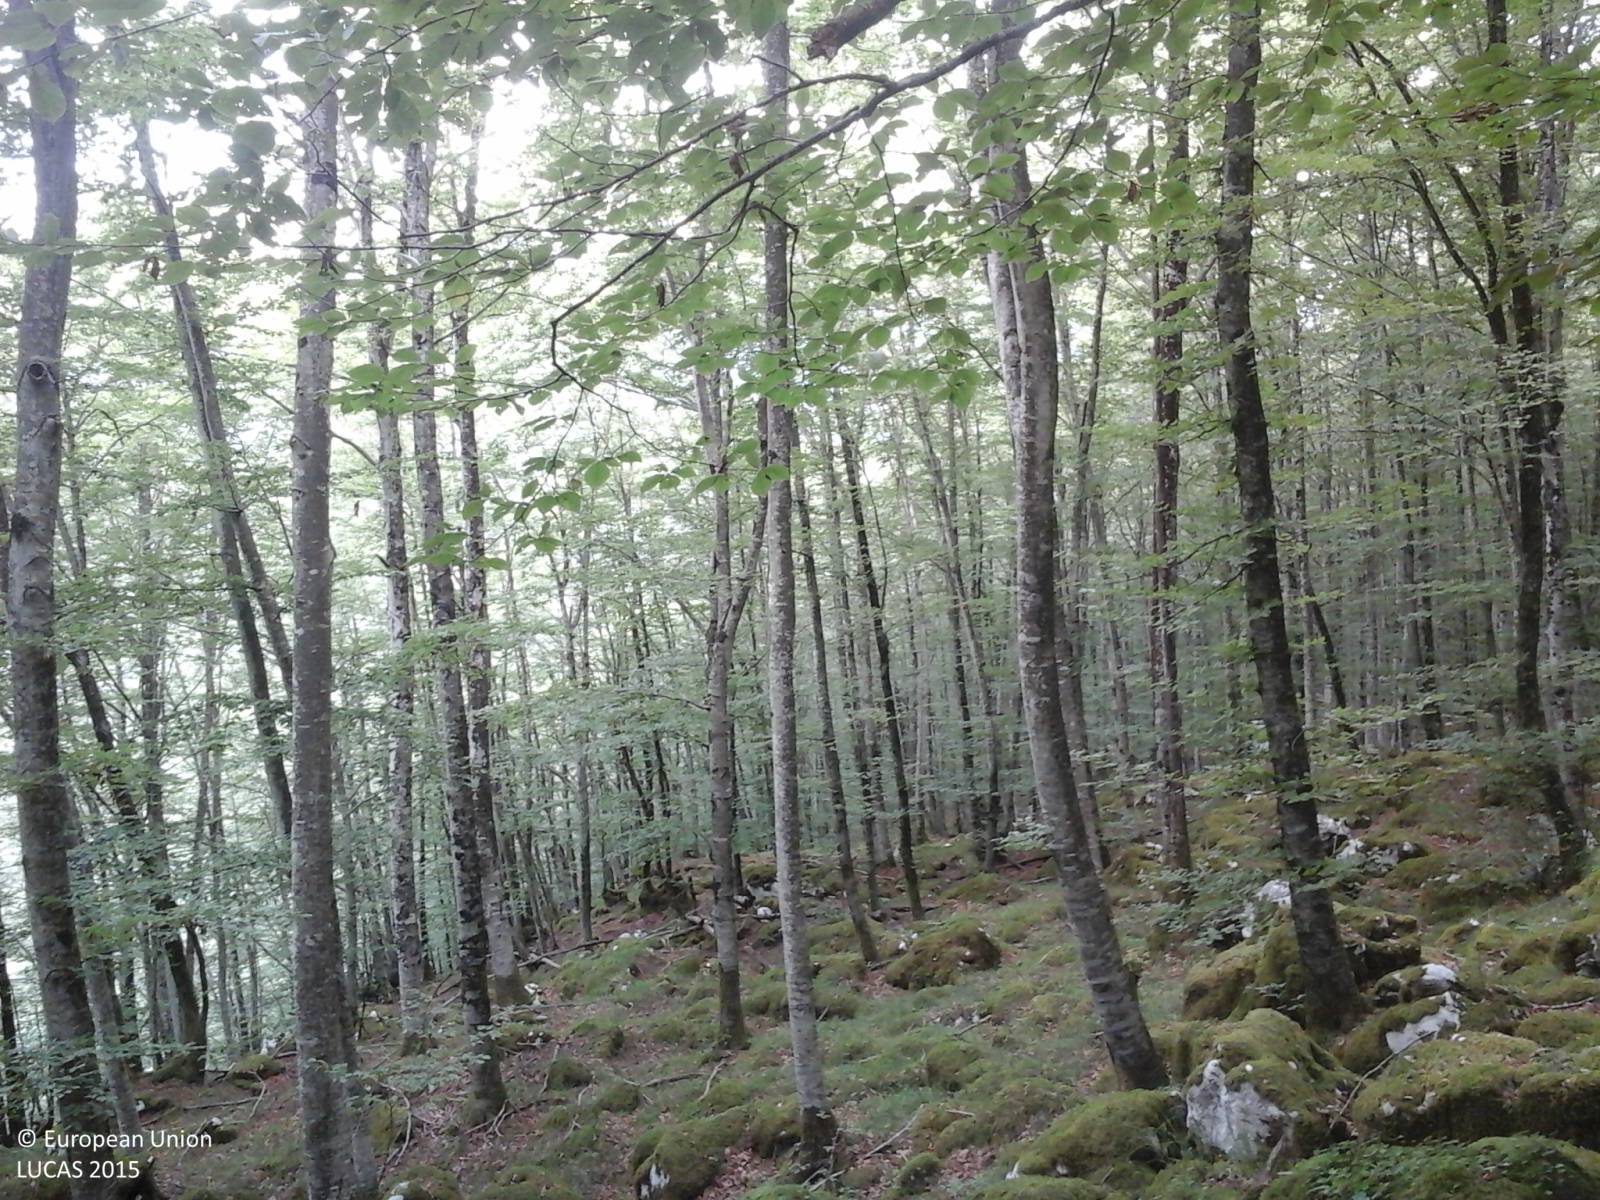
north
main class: Woodland
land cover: Broadleaved woodland
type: mountainous beech forest
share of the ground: > 75 %
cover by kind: broadleaved forest trees 100 %
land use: Forestry
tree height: > 5 m
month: July
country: IT
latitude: 46.1767
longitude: 12.5488
